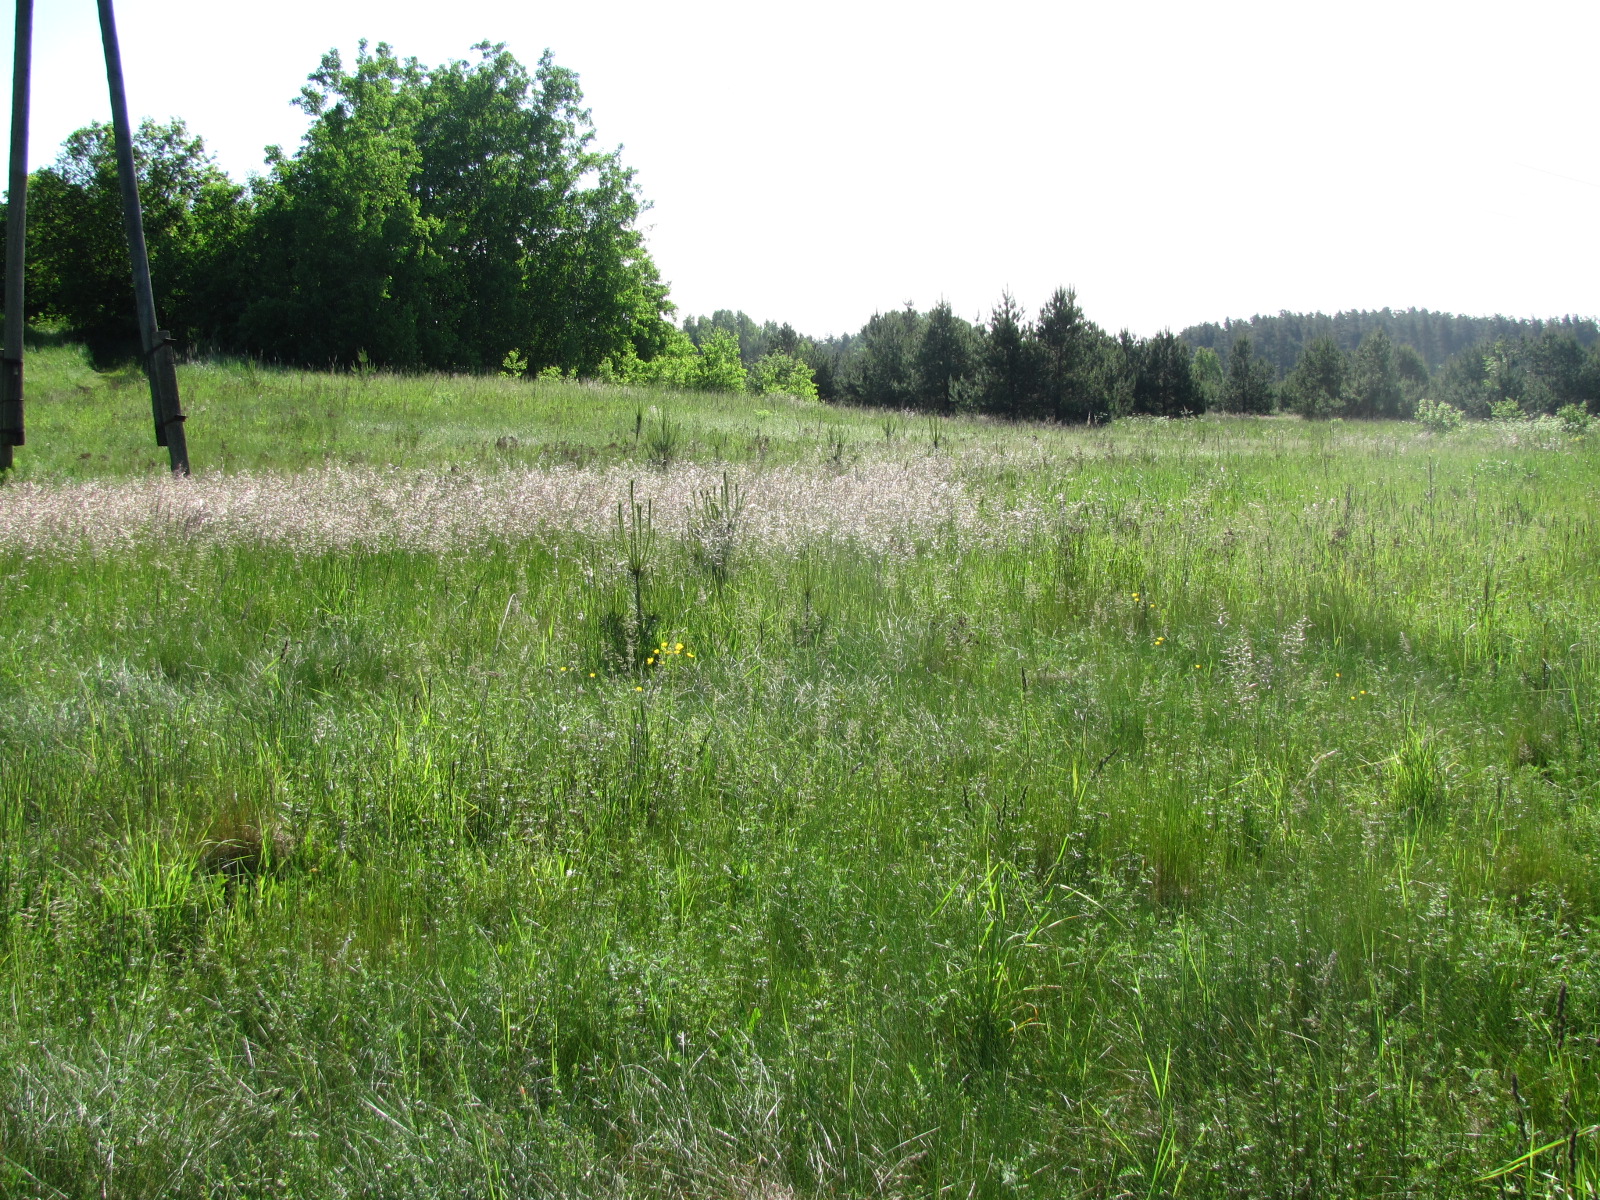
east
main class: Grassland
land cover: Grassland without tree/shrub cover
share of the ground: > 75 %
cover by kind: herbaceous plants 100 %
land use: Agriculture (excluding fallow land and kitchen gardens)
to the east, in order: Grassland without tree/shrub cover; Electric lines; Grassland without tree/shrub cover; Tracks; Grassland without tree/shrub cover; Broadleaved woodland; Grassland with sparse tree/shrub cover; Grassland without tree/shrub cover
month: June
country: LV
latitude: 56.8441
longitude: 24.4714
